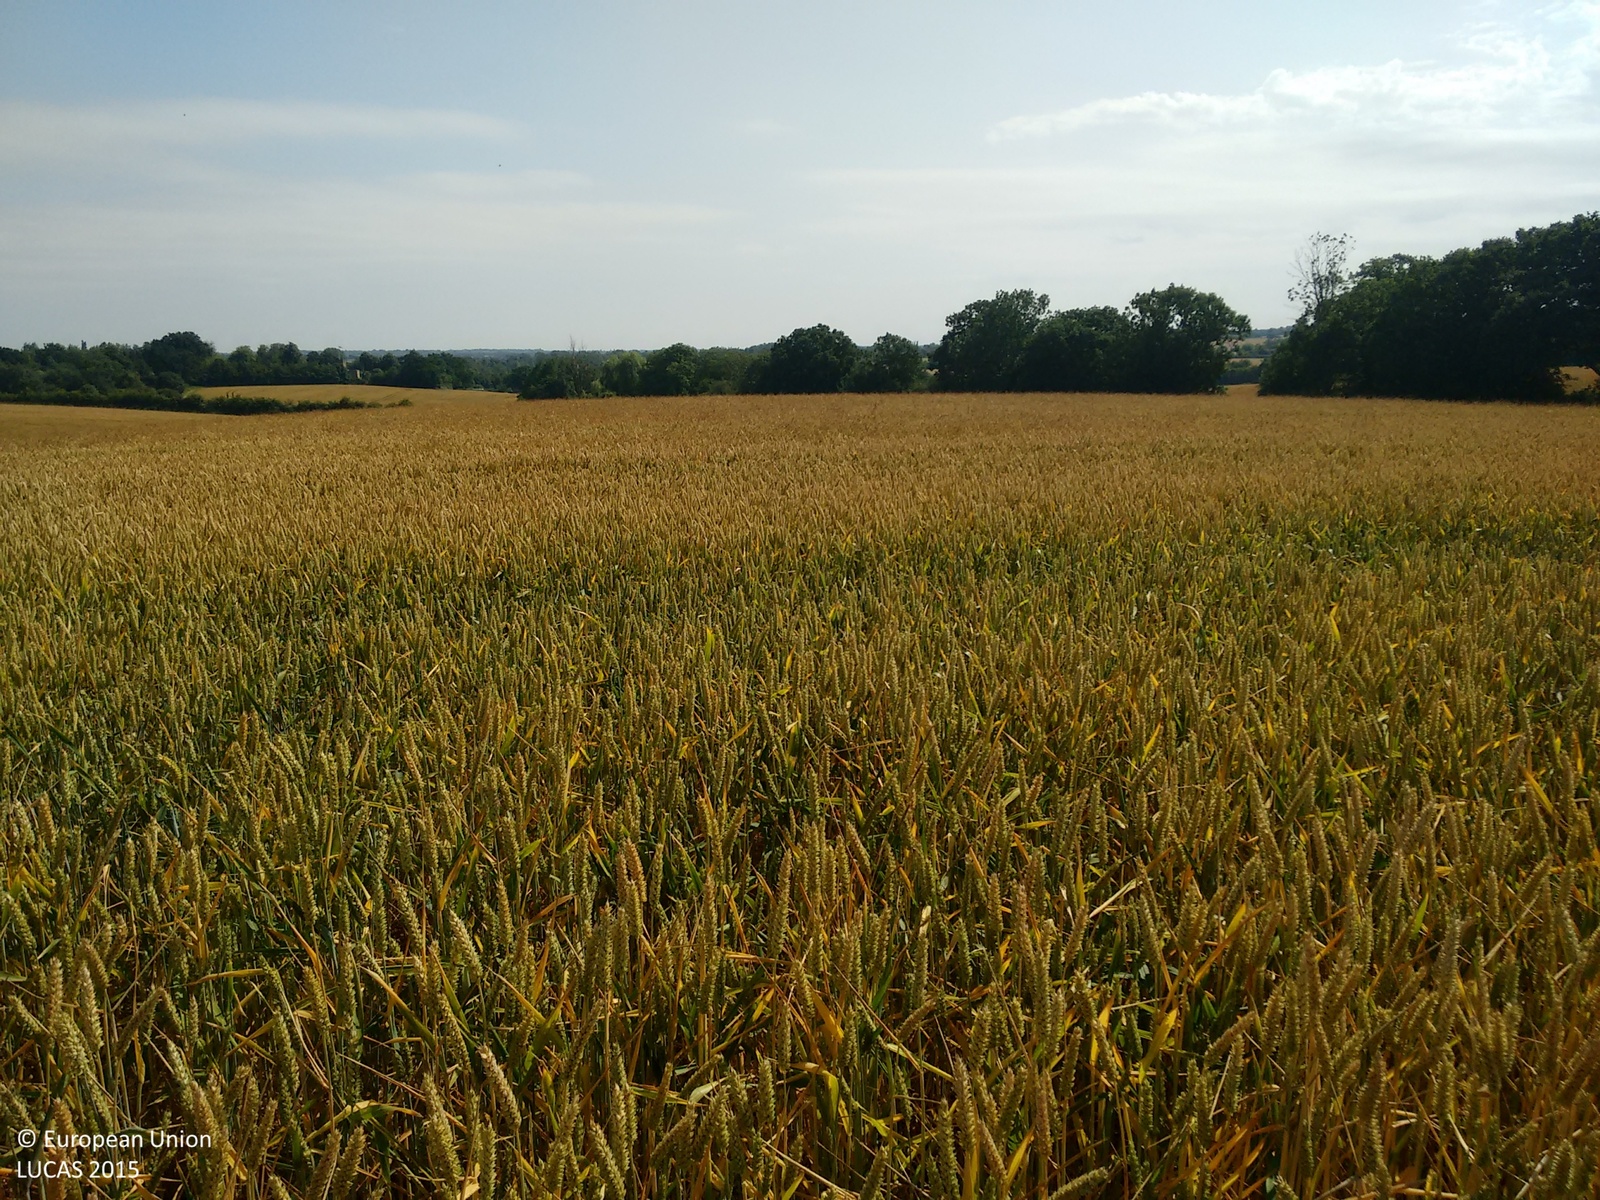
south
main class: Grassland
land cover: Spontaneously vegetated surfaces
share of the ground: > 75 %
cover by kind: herbaceous plants 100 %
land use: Fallow land
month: July
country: GB
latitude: 51.6985
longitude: 0.4075
